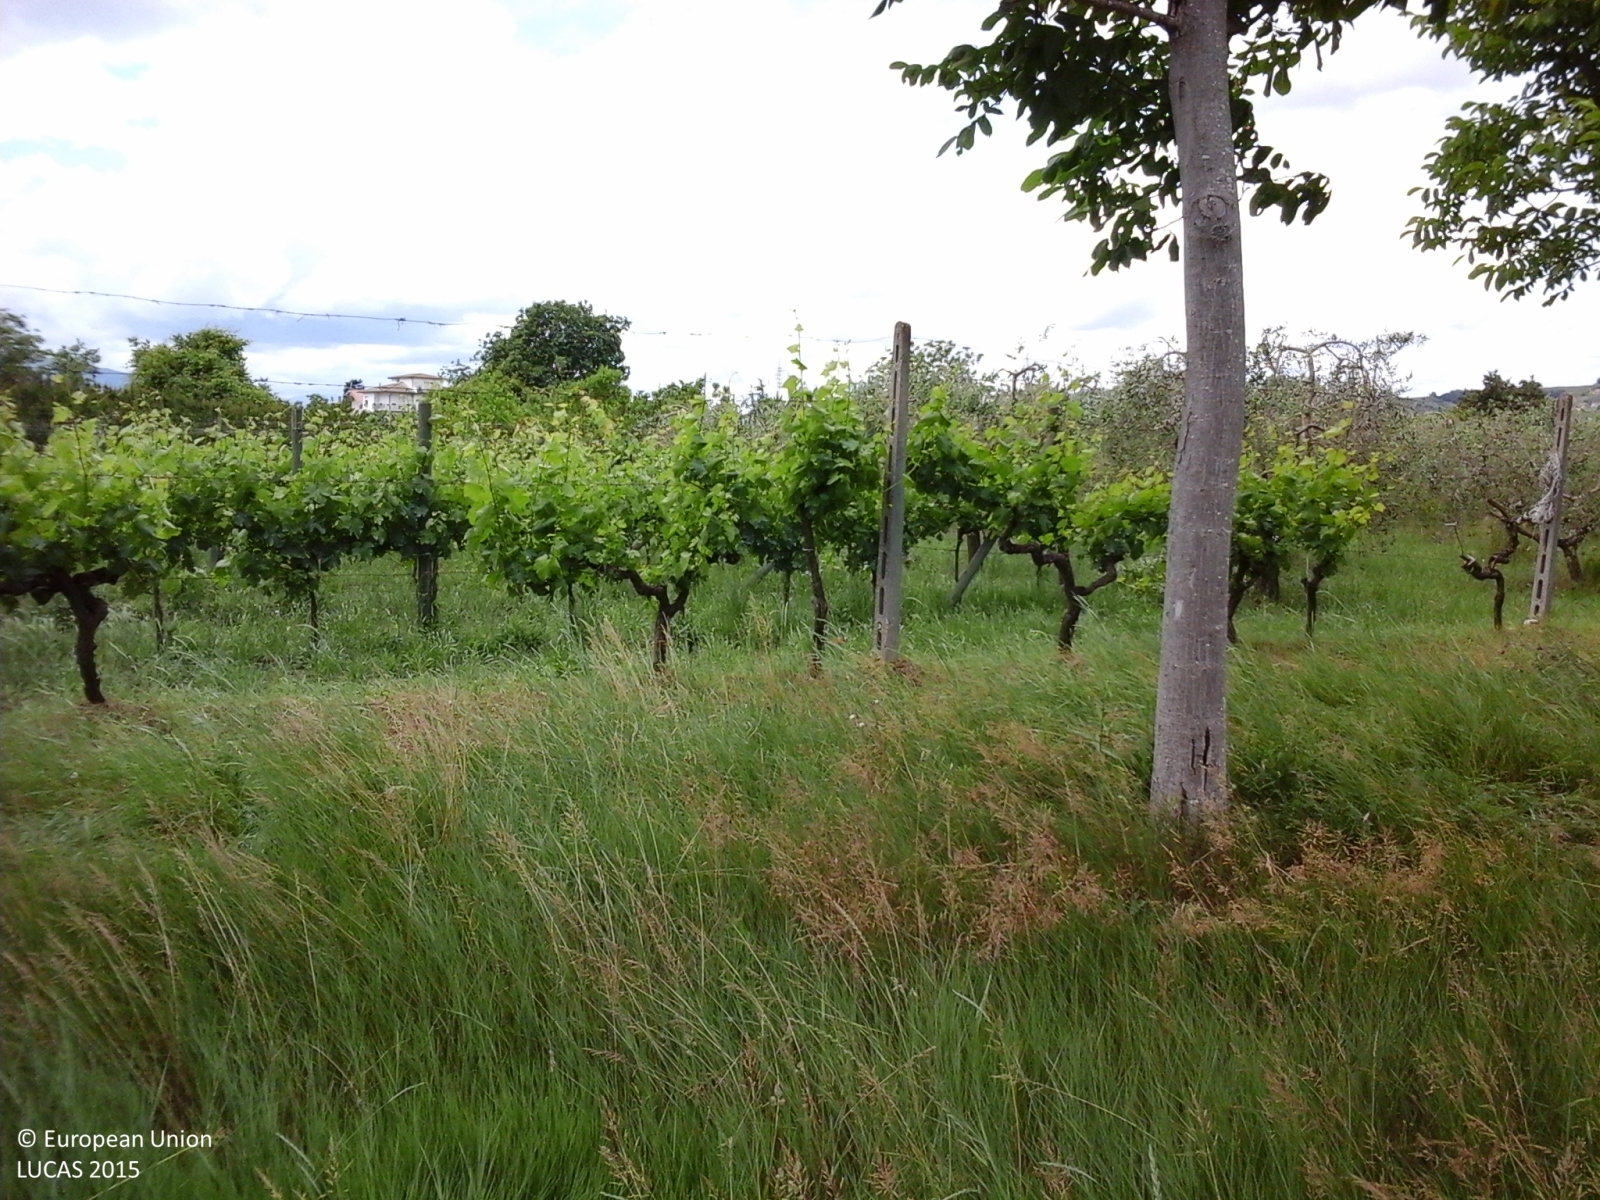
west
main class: Cropland
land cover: Nuts trees
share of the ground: > 75 %
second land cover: Grassland without tree/shrub cover
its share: > 75 %
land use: Agriculture (excluding fallow land and kitchen gardens)
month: May
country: IT
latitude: 42.8721
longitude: 13.7966
